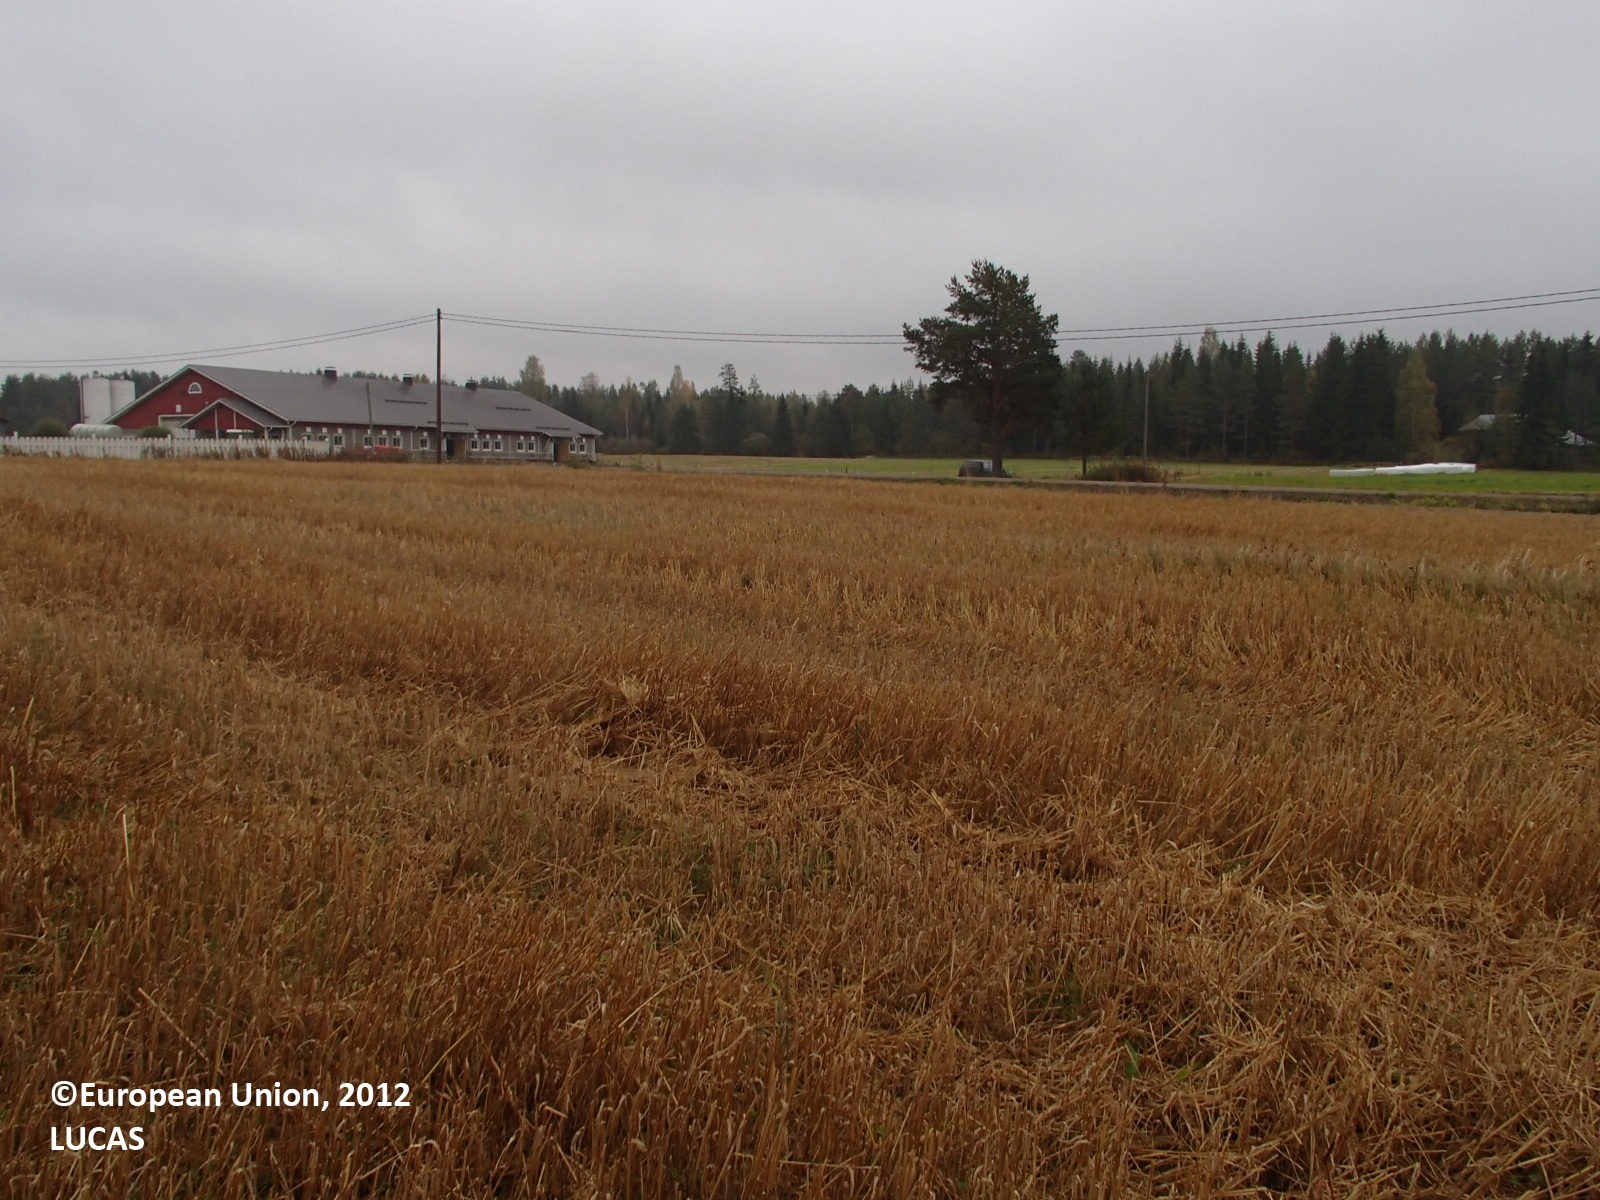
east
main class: Cropland
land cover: Barley
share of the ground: > 75 %
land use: Agriculture (excluding fallow land and kitchen gardens)
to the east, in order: Barley; Grass margins; Ditches and canals; Grass margins; Electric lines; Grass margins; Paved roads, cycling and walking lanes; Grass margins; Ditches and canals; Grass margins; Fences; Grassland with sparse tree/shrub cover
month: September
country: FI
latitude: 63.8946
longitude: 26.8549
